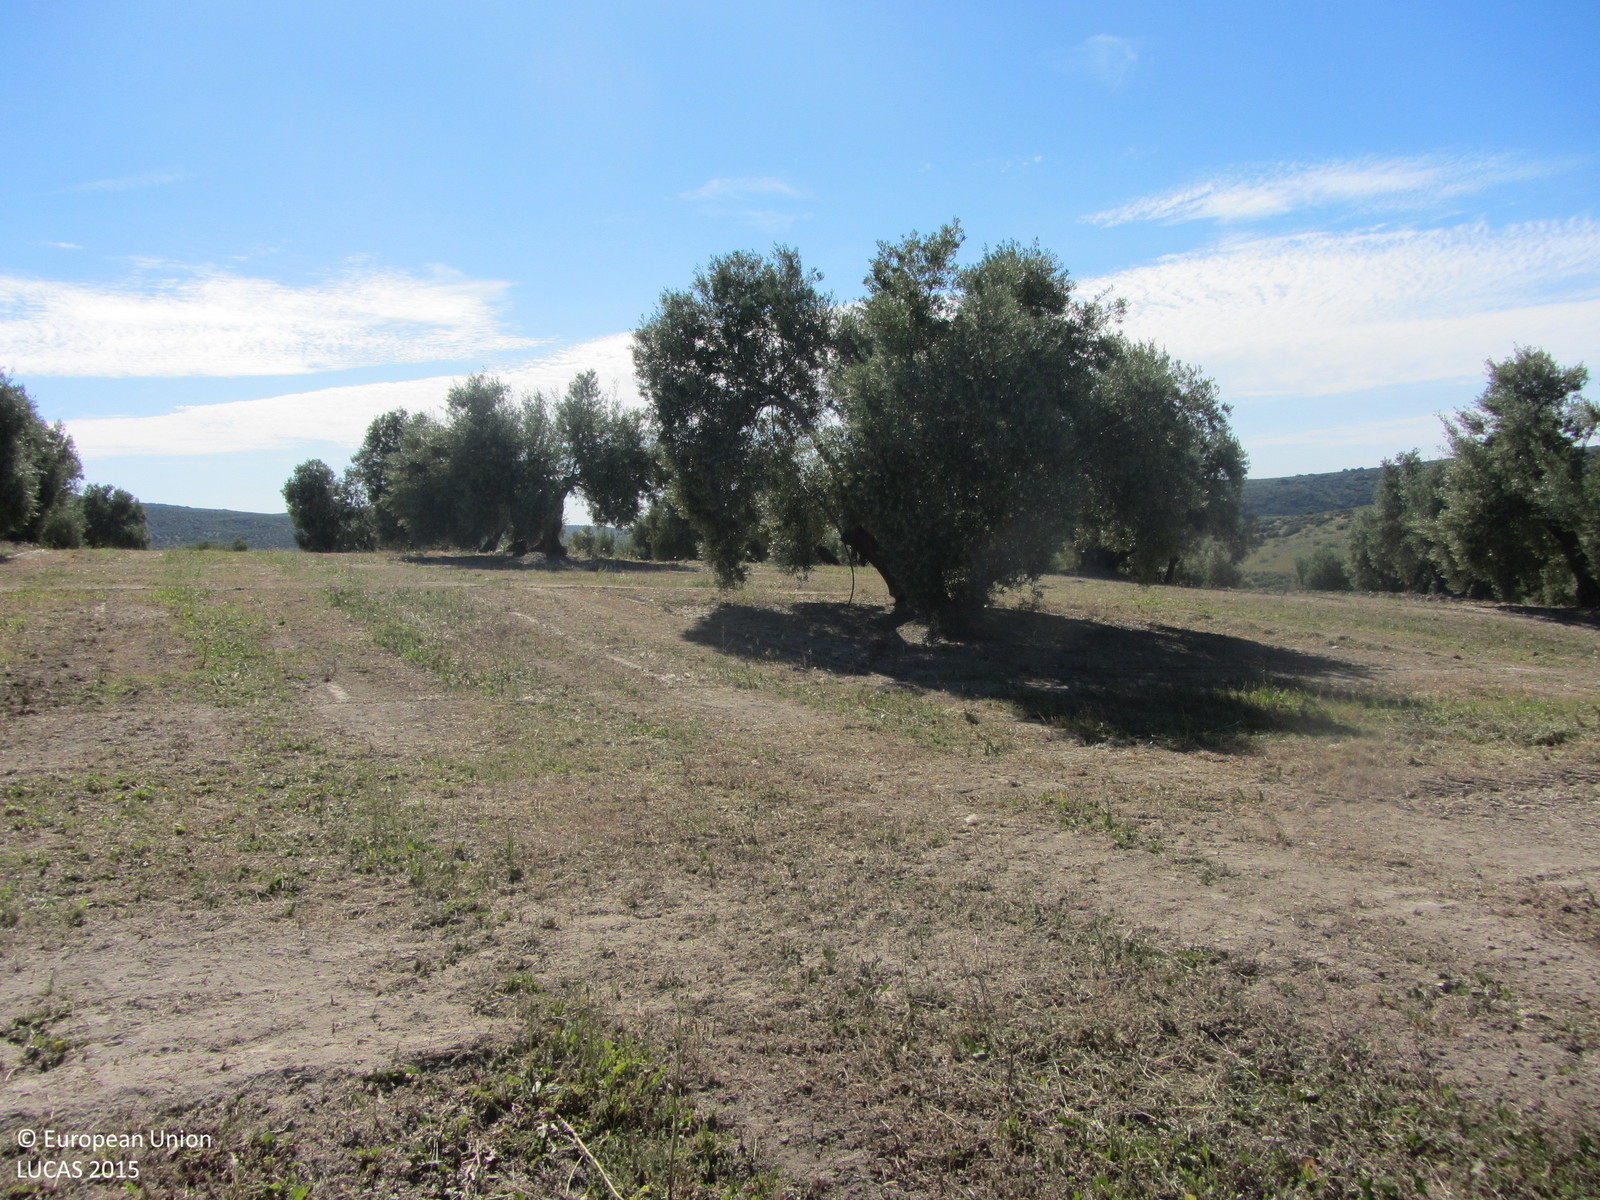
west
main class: Cropland
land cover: Olive groves
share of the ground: 25 - 50 %
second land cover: Spontaneously vegetated surfaces
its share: 50 - 75 %
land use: Agriculture (excluding fallow land and kitchen gardens)
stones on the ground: < 10 %
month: May
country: ES
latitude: 38.0763
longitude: -3.4190
